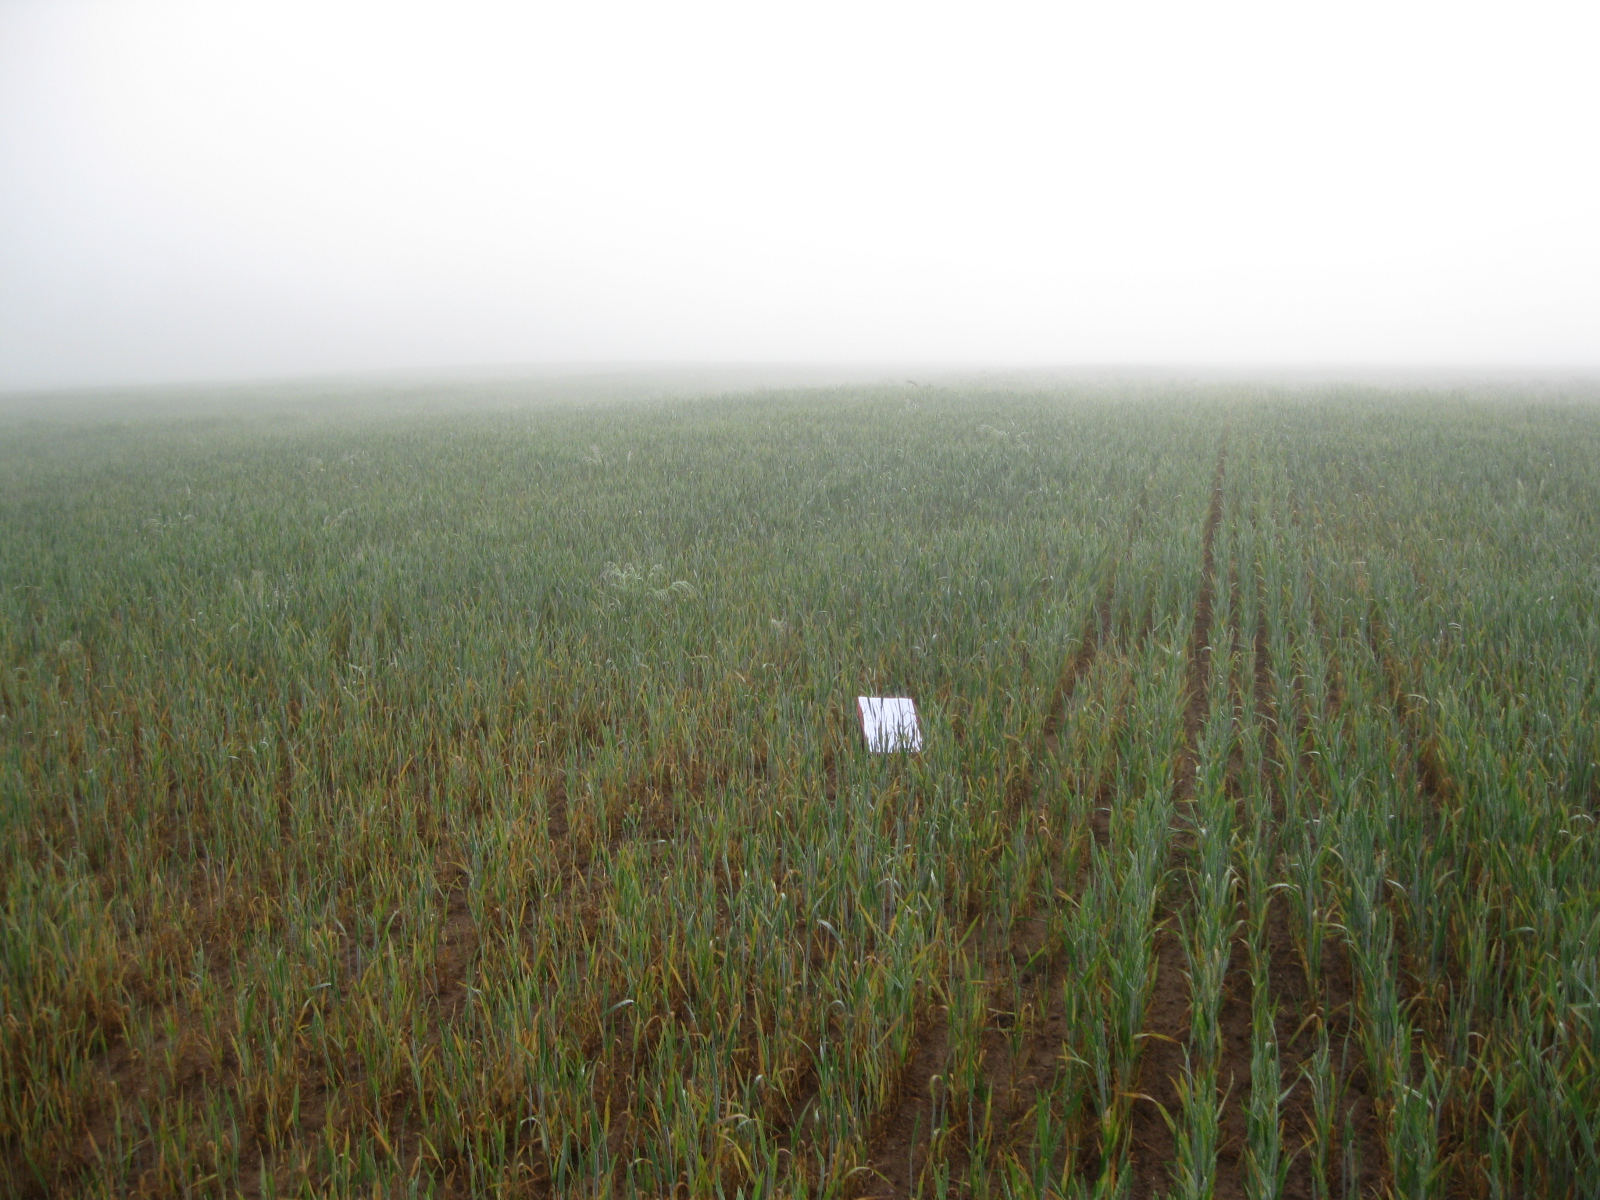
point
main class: Cropland
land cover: Common wheat
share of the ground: > 75 %
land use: Agriculture (excluding fallow land and kitchen gardens)
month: June
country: LT
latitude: 55.4353
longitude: 23.9814
